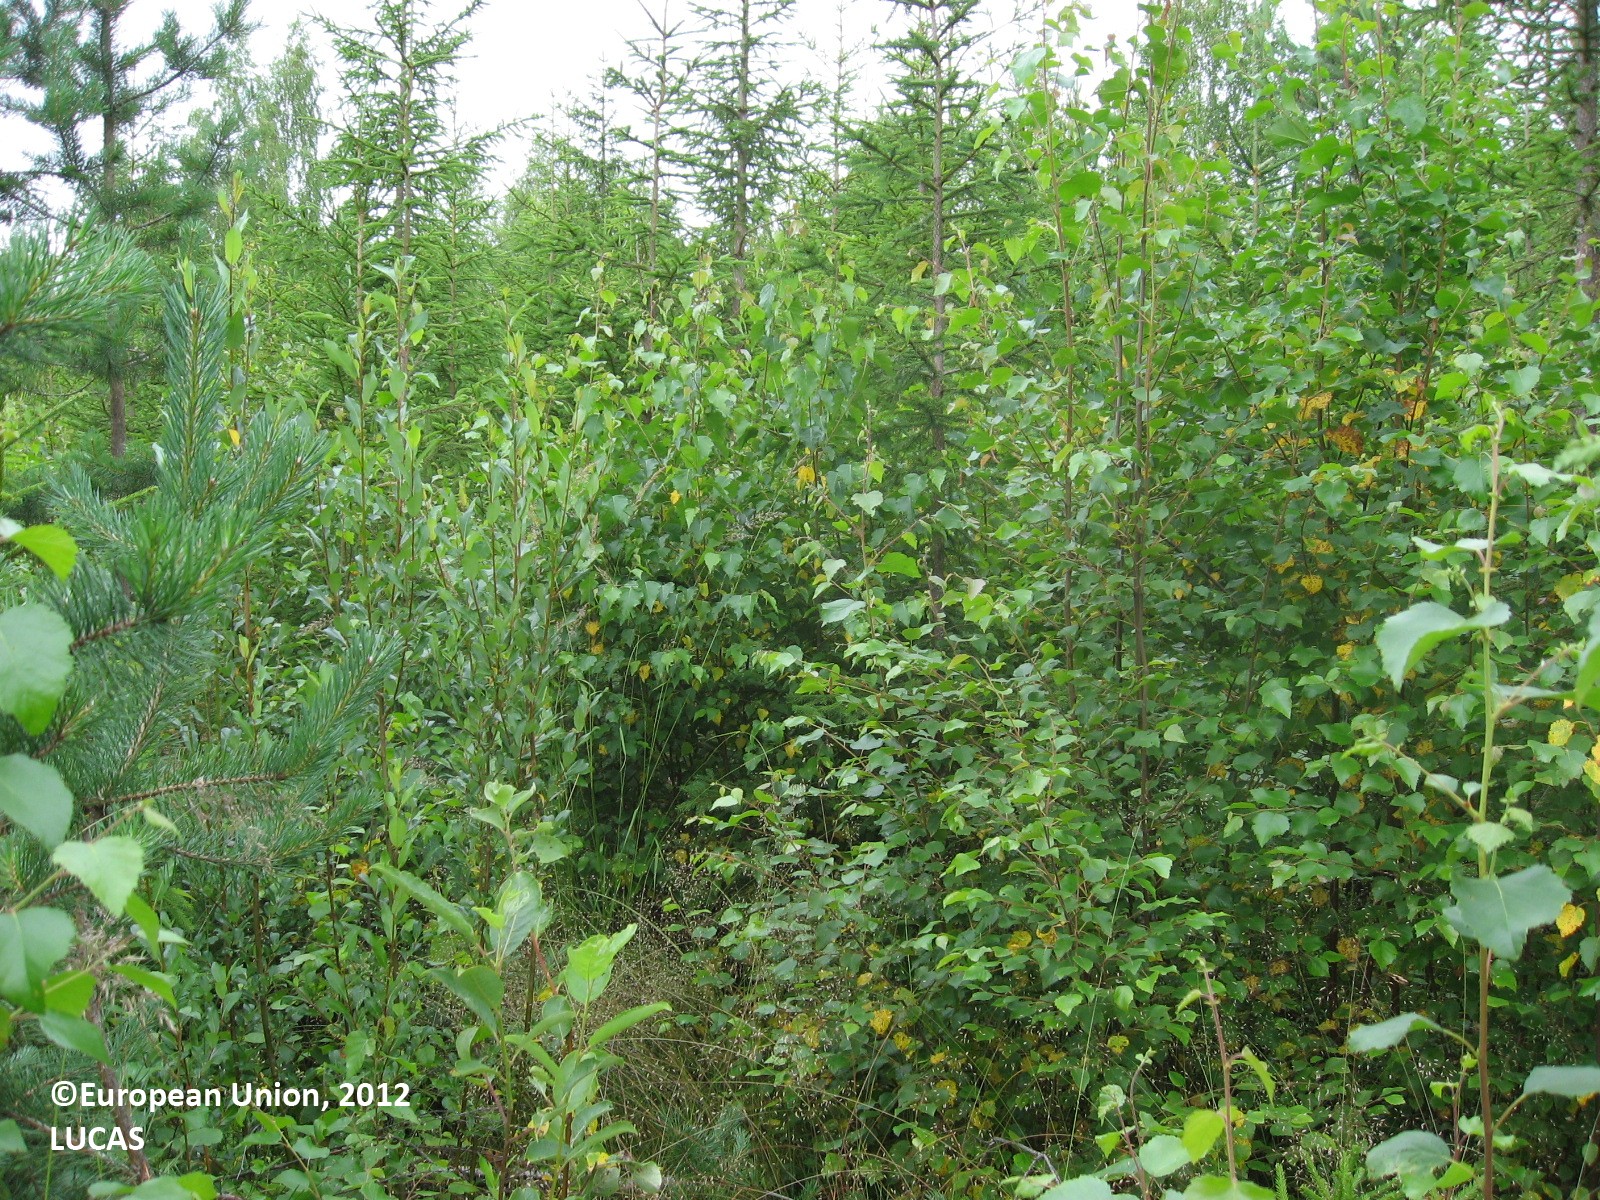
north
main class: Woodland
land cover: Spruce dominated mixed woodland
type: boreal forest
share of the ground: > 75 %
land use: Forestry
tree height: < 5 m
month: July
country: FI
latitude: 61.3844
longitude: 25.9497
